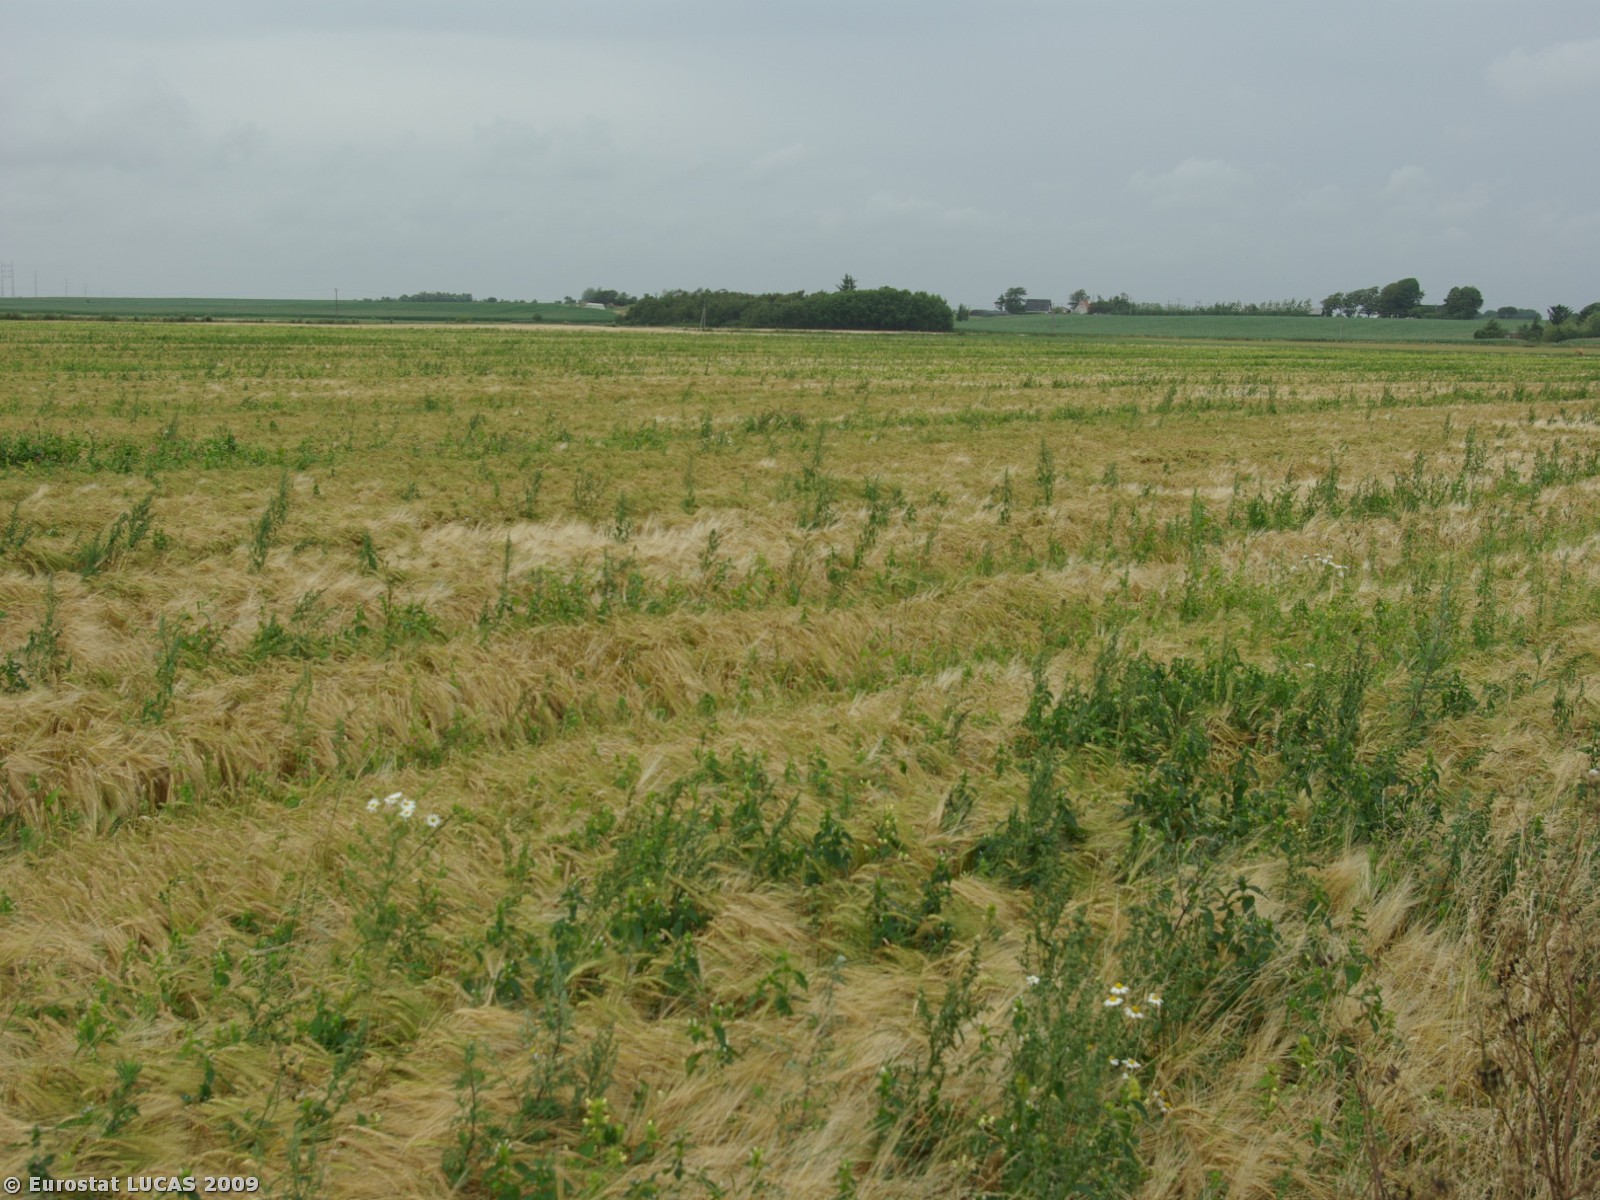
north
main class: Cropland
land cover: Barley
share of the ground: > 75 %
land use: Agriculture (excluding fallow land and kitchen gardens)
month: July
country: DK
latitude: 55.1041
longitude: 8.8567
